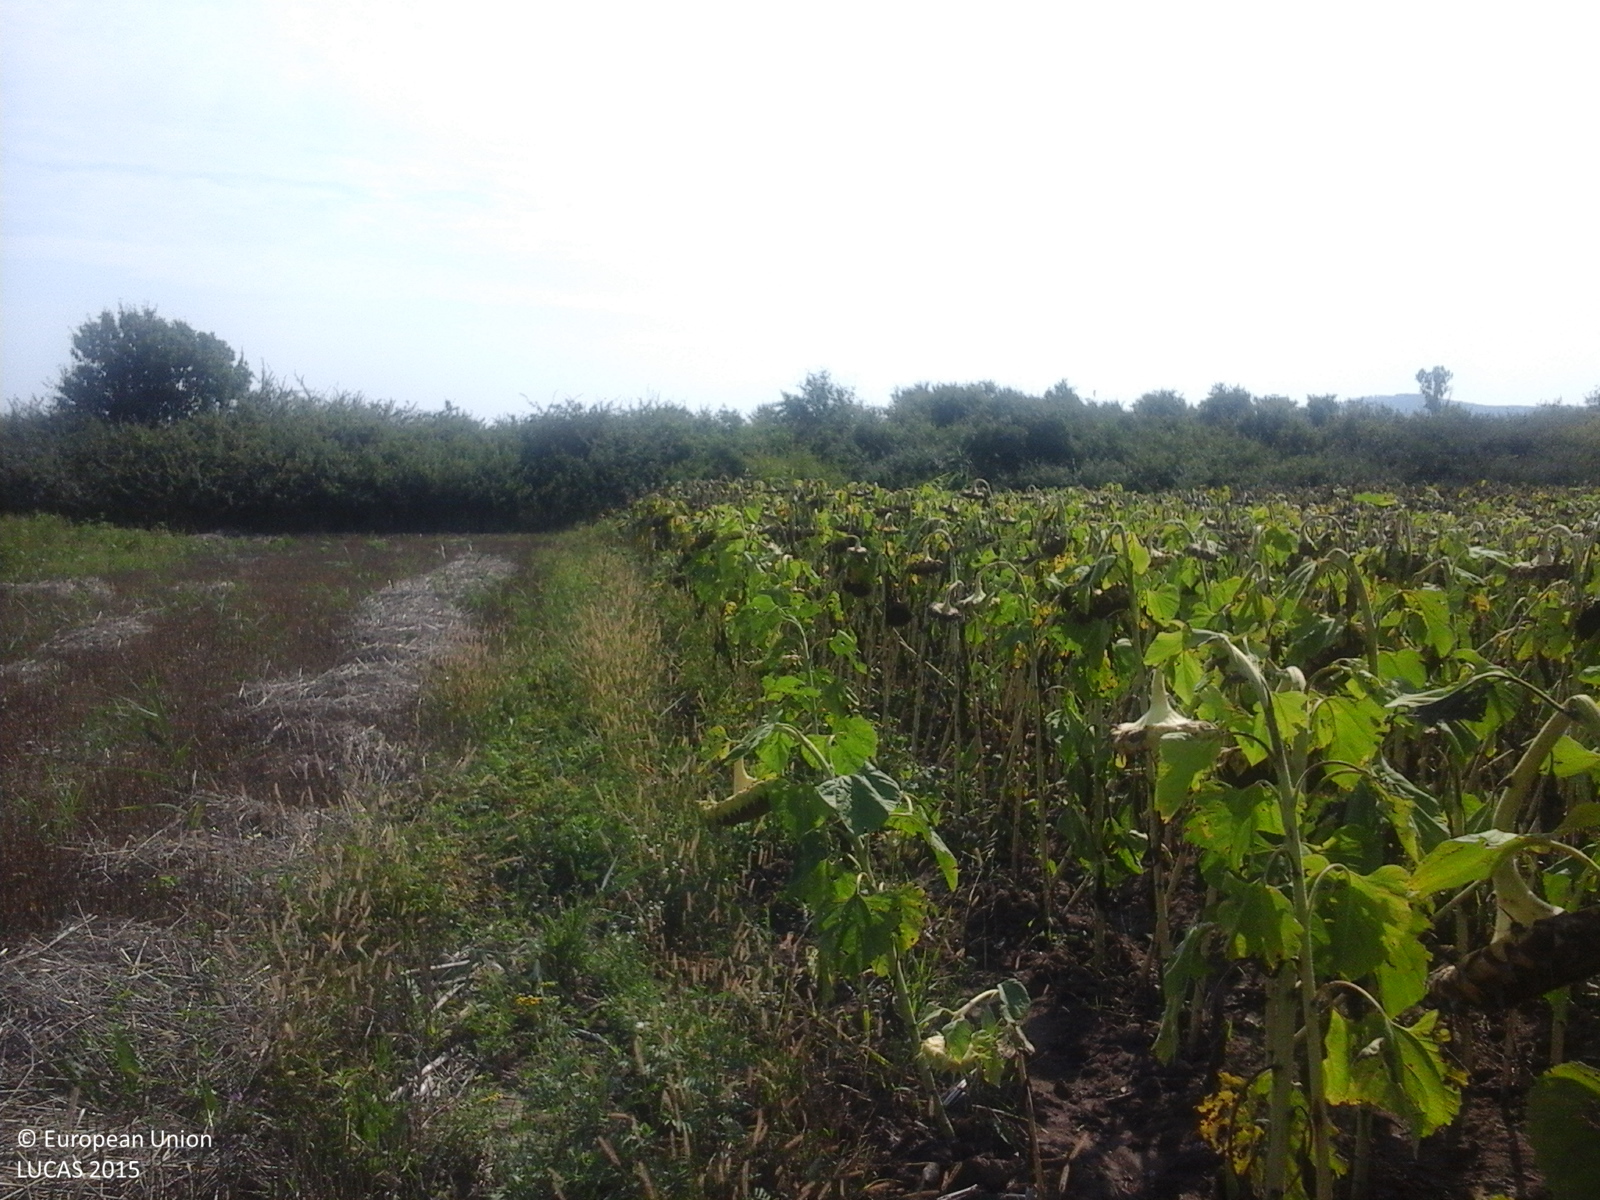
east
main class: Cropland
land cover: Sunflower
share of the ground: > 75 %
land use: Agriculture (excluding fallow land and kitchen gardens)
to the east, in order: Sunflower; Broadleaved woodland; Ditches and canals; Broadleaved woodland; Grass margins; Maize
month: August
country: RO
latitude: 46.3063
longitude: 21.8702
